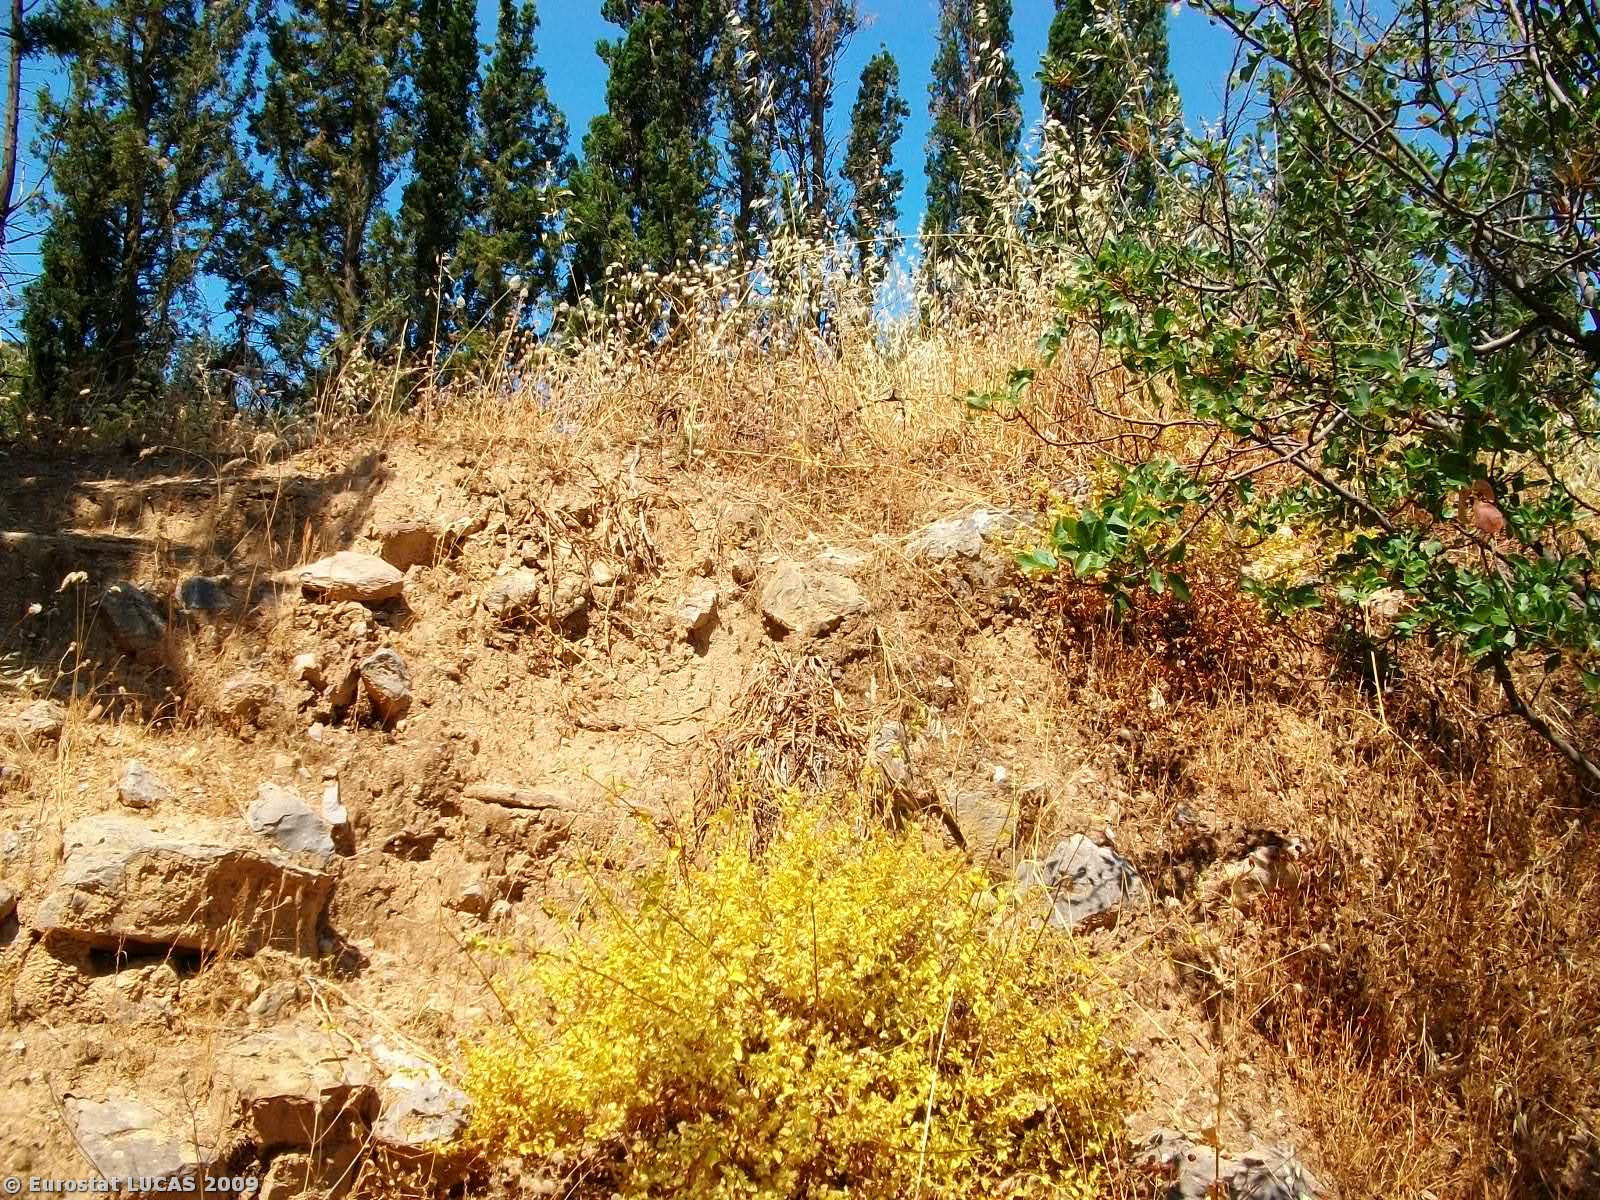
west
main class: Shrubland
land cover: Shrubland with sparse tree cover
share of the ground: 50 - 75 %
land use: Unused
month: July
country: GR
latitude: 38.3655
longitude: 22.3683
